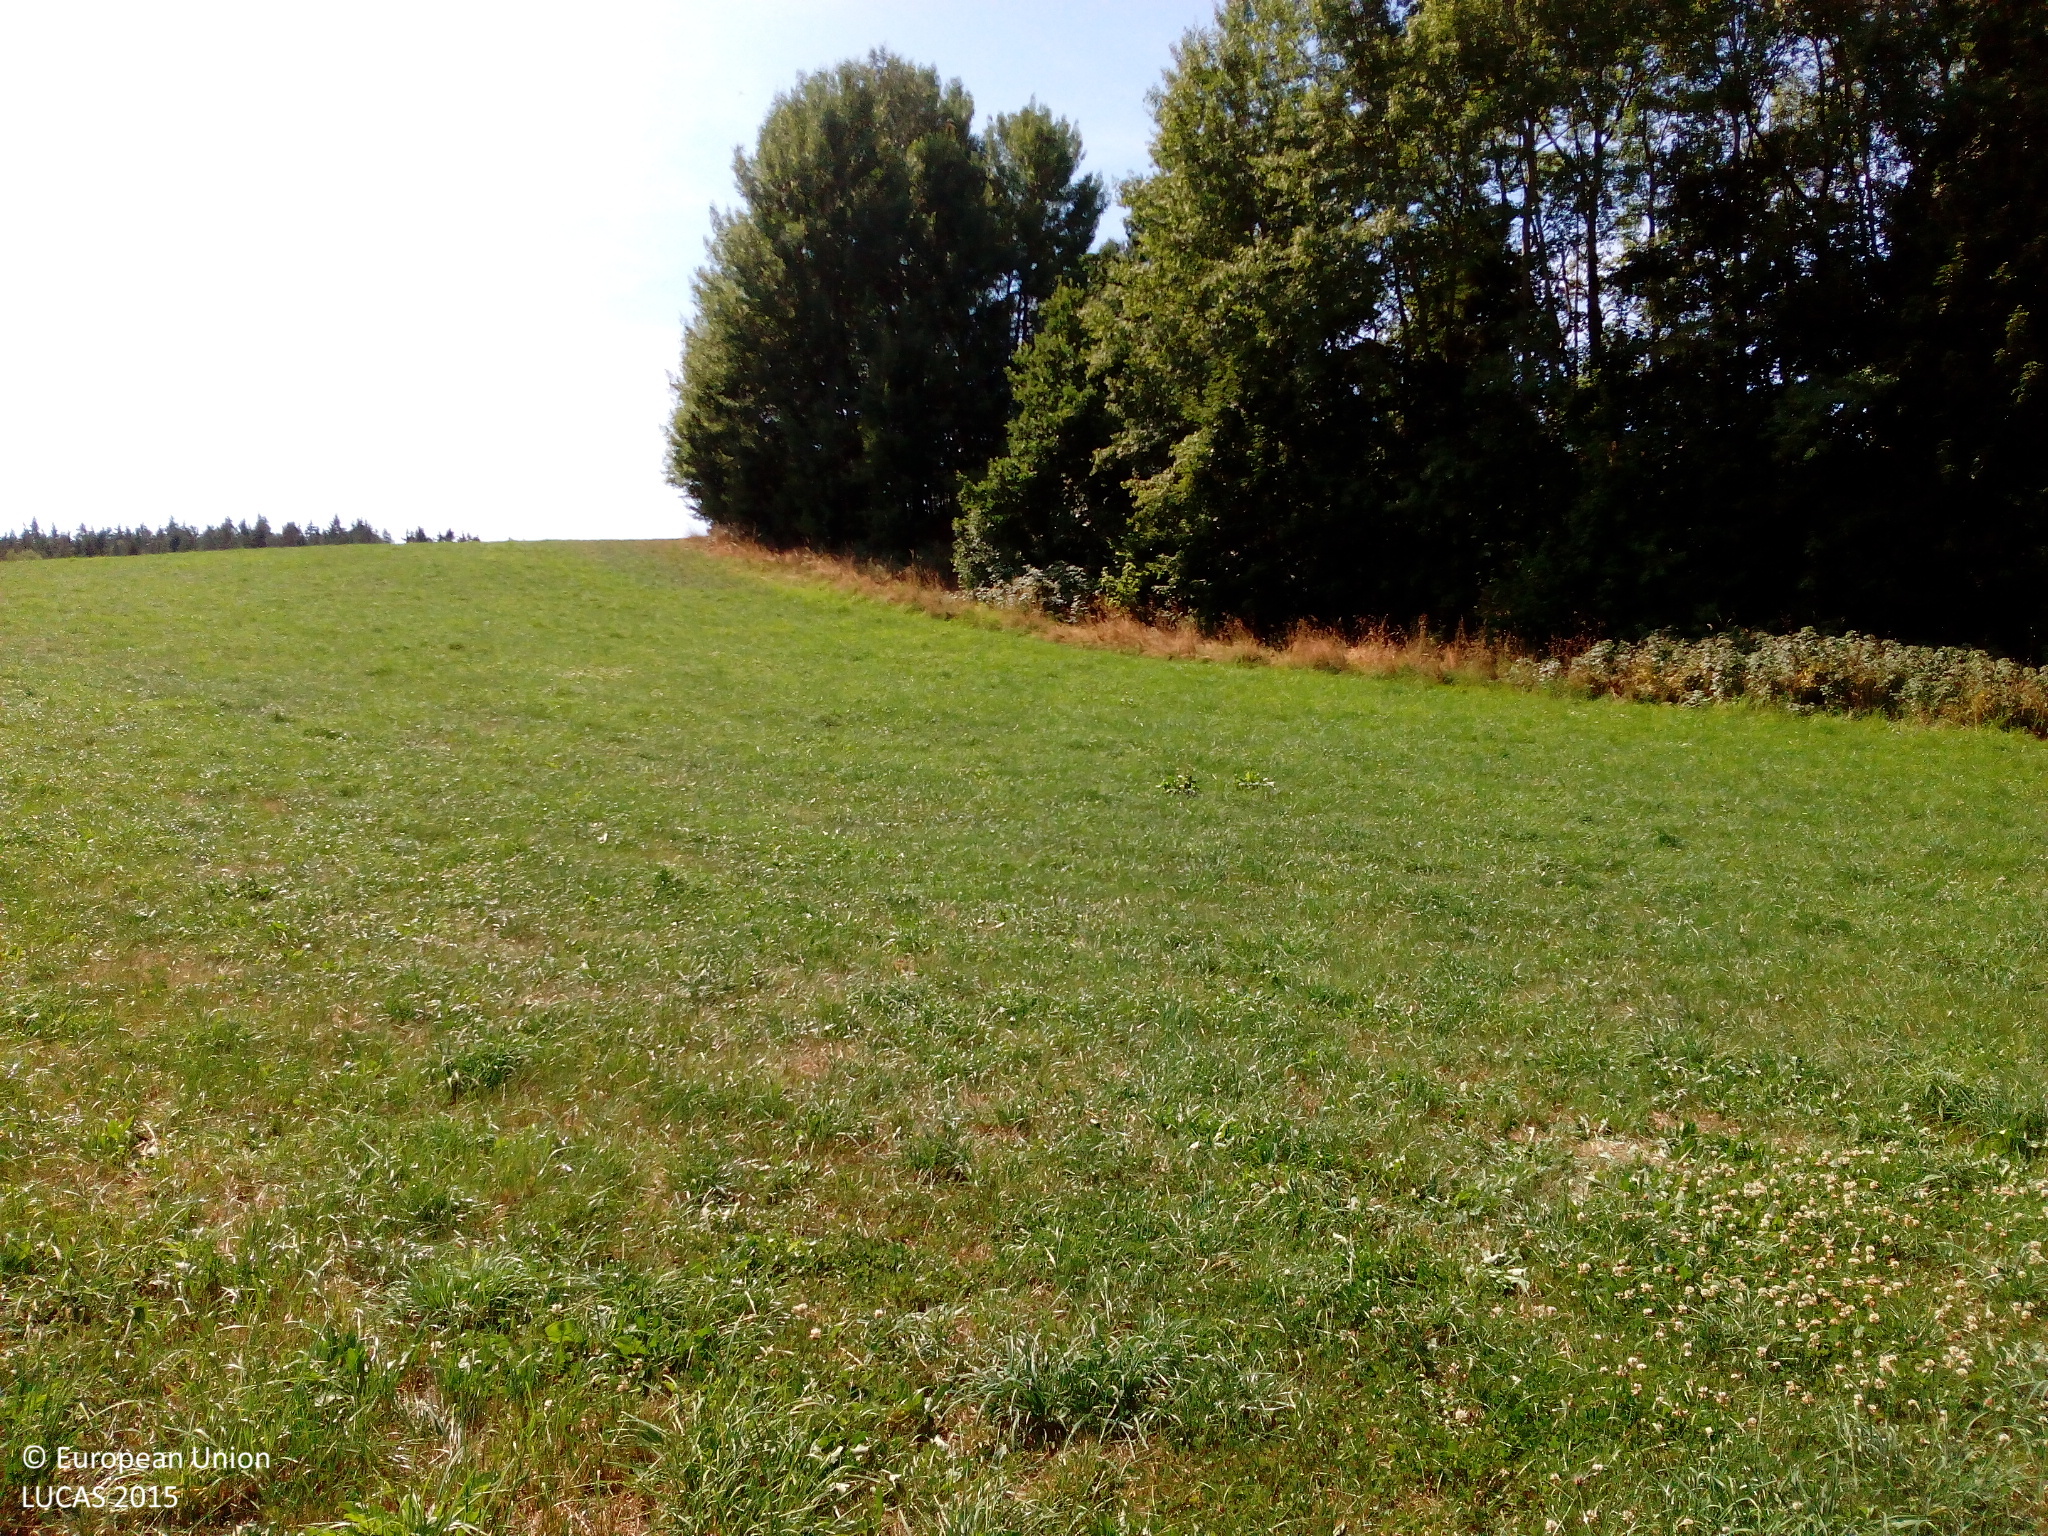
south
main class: Grassland
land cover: Grassland without tree/shrub cover
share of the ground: > 75 %
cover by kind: herbaceous plants 85 %, unconsolidated bare surface 10 %
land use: Agriculture (excluding fallow land and kitchen gardens)
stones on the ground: < 10 %
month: August
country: DE
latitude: 49.8564
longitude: 12.2390
